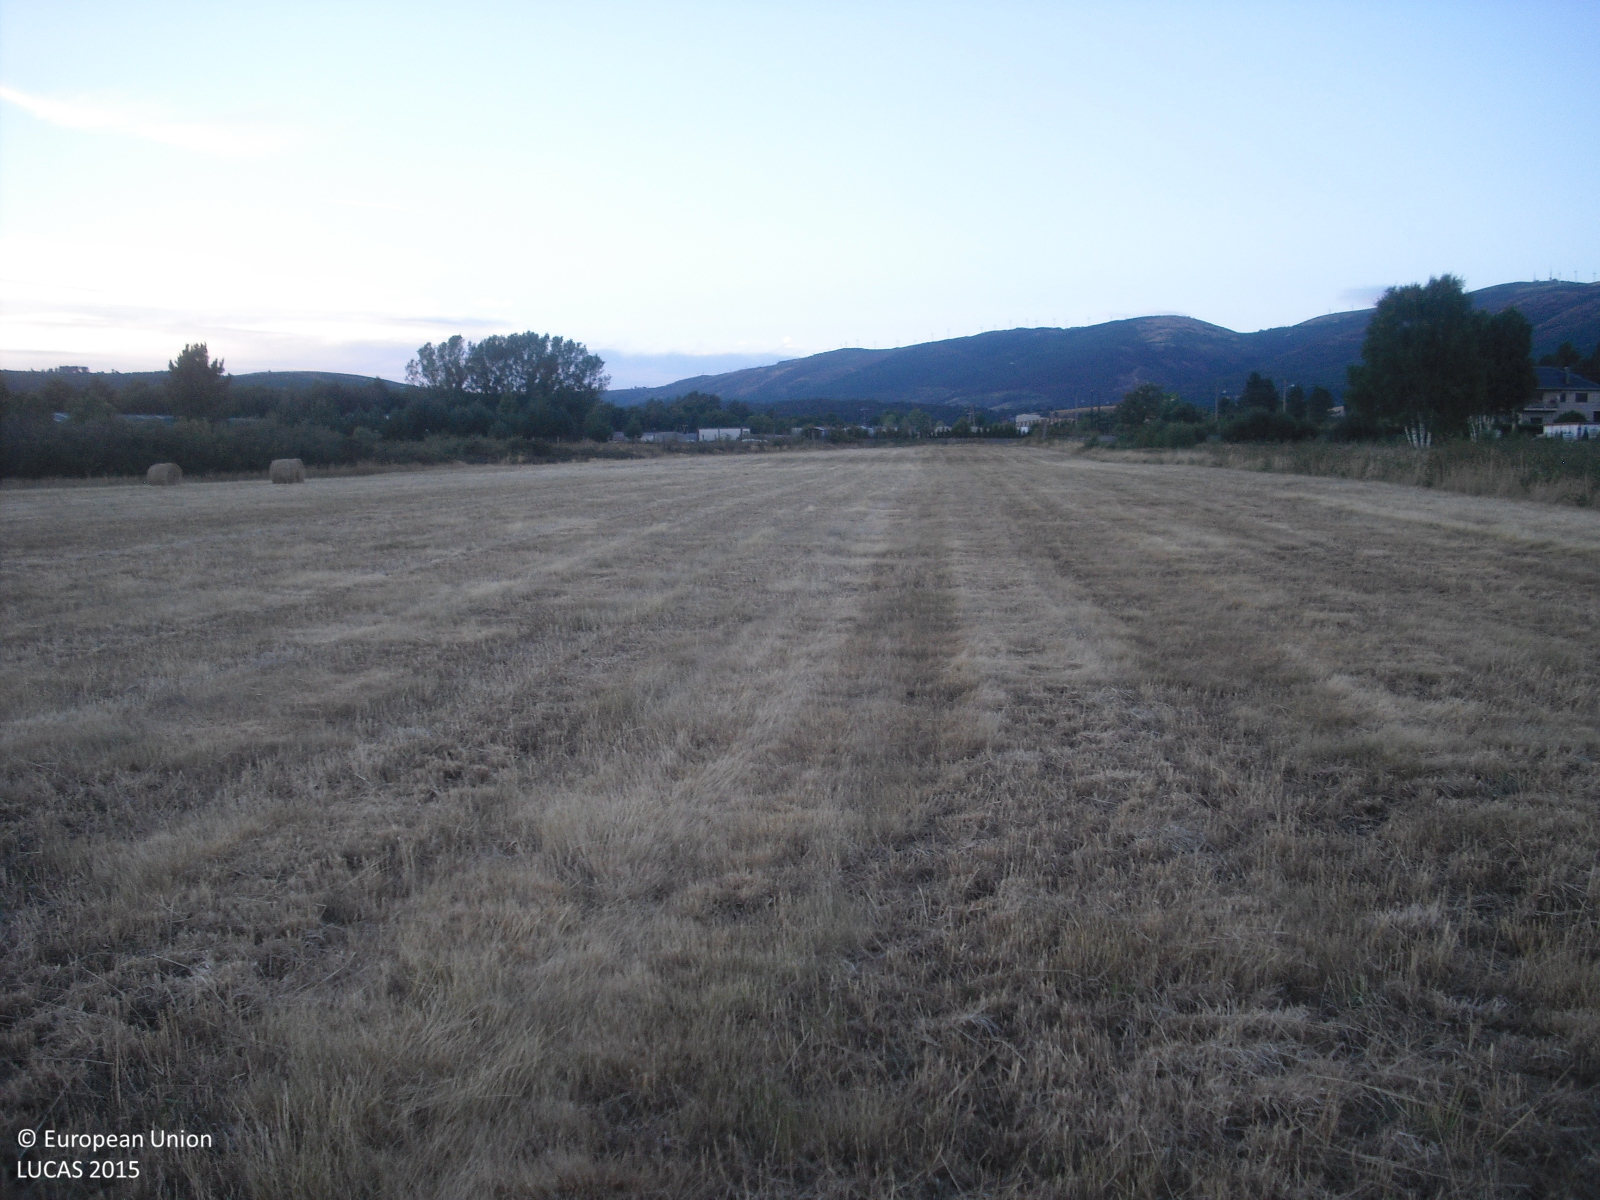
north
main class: Cropland
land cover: Temporary grasslands
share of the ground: > 75 %
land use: Agriculture (excluding fallow land and kitchen gardens)
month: July
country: ES
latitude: 42.2893
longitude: -7.6436
